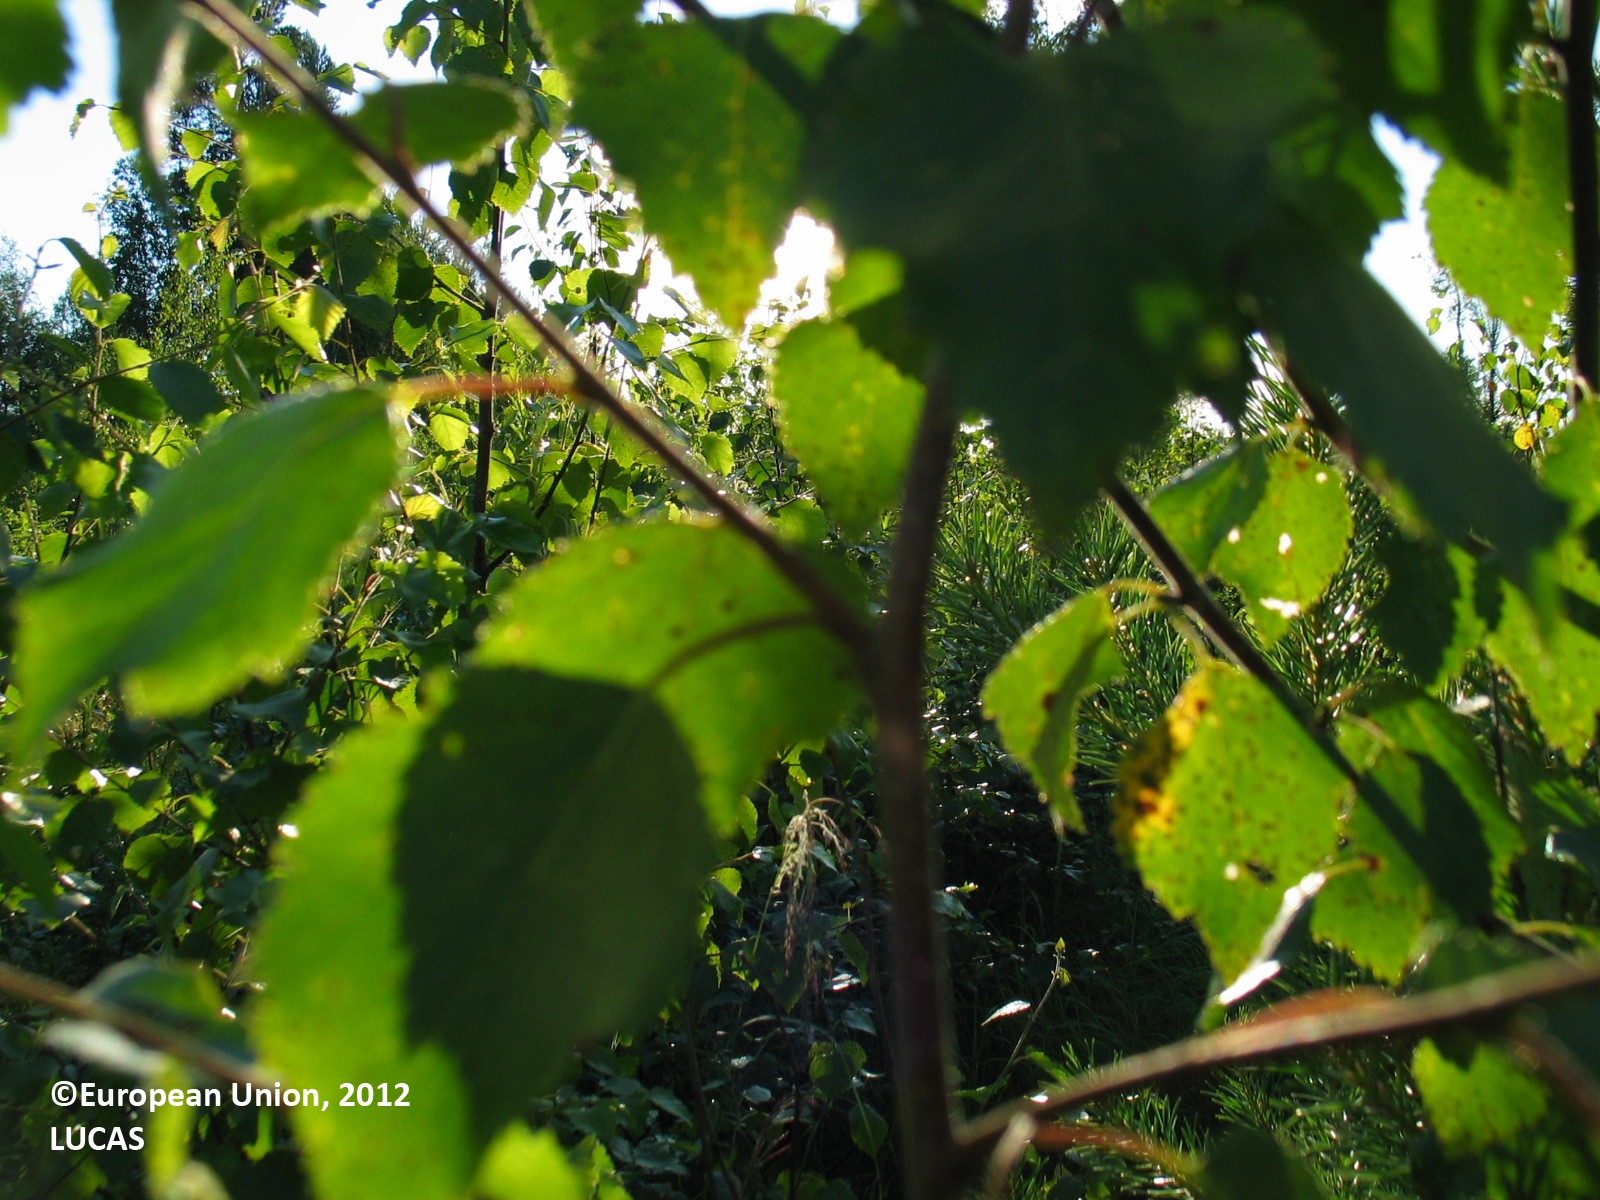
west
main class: Woodland
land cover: Pine dominated mixed woodland
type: boreal forest
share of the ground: 50 - 75 %
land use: Forestry
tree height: < 5 m
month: July
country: FI
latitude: 64.6384
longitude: 26.4964
